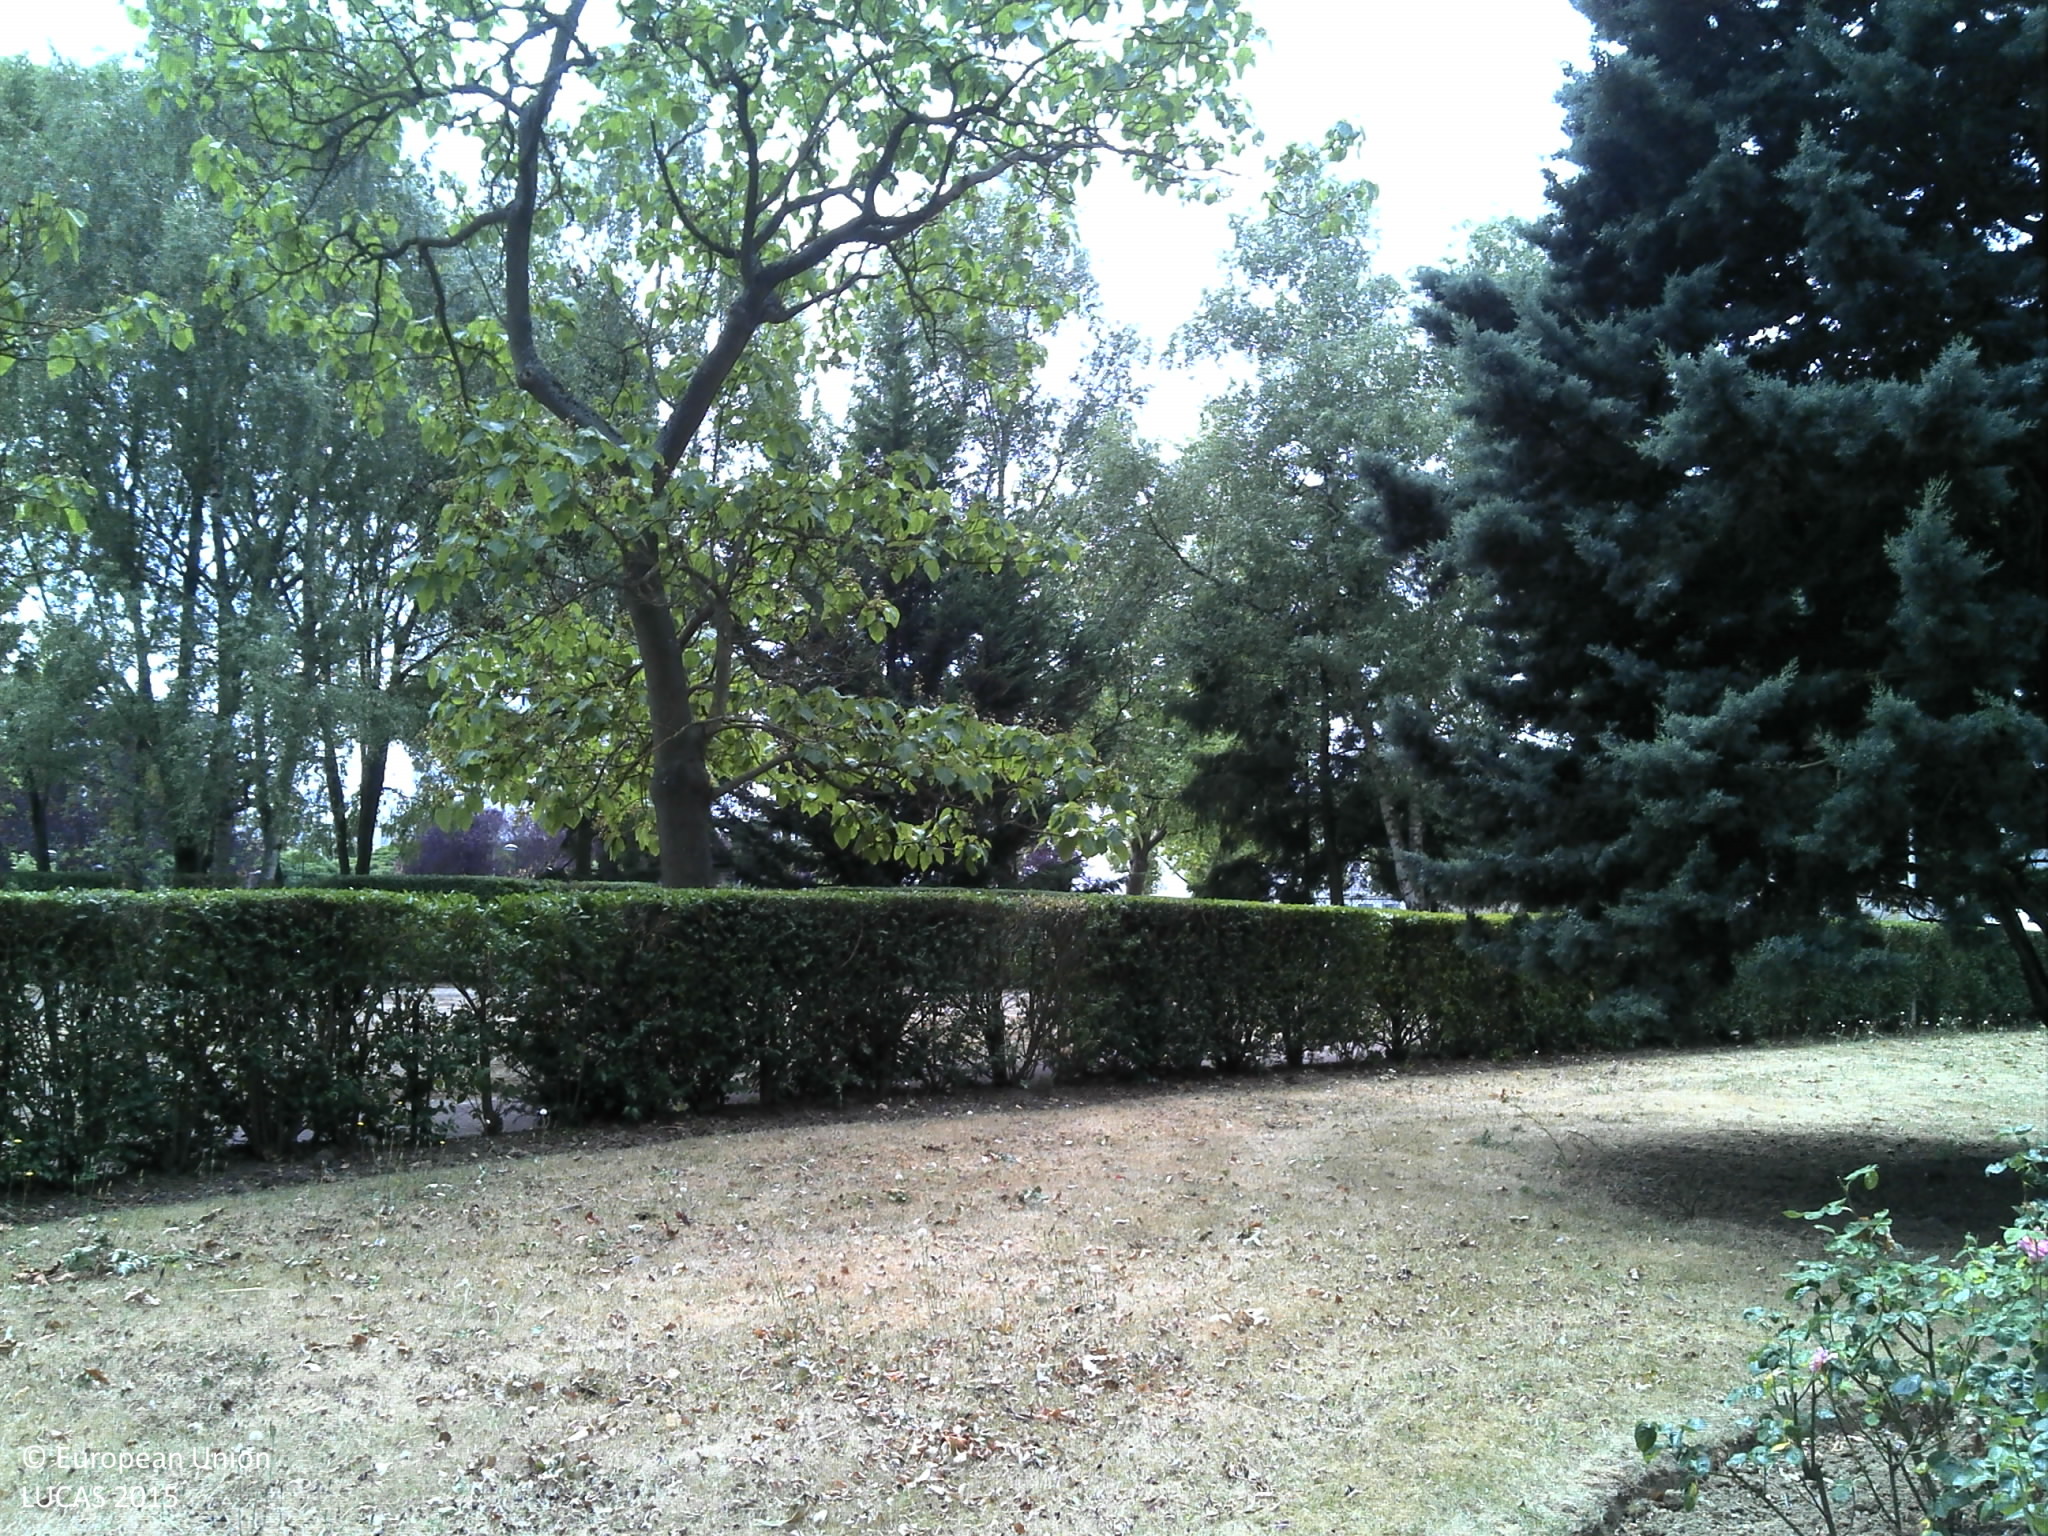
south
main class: Grassland
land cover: Grassland with sparse tree/shrub cover
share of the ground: > 75 %
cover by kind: herbaceous plants 95 %, broadleaved forest trees 5 %
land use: Residential
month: July
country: FR
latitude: 48.6478
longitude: 2.4011
